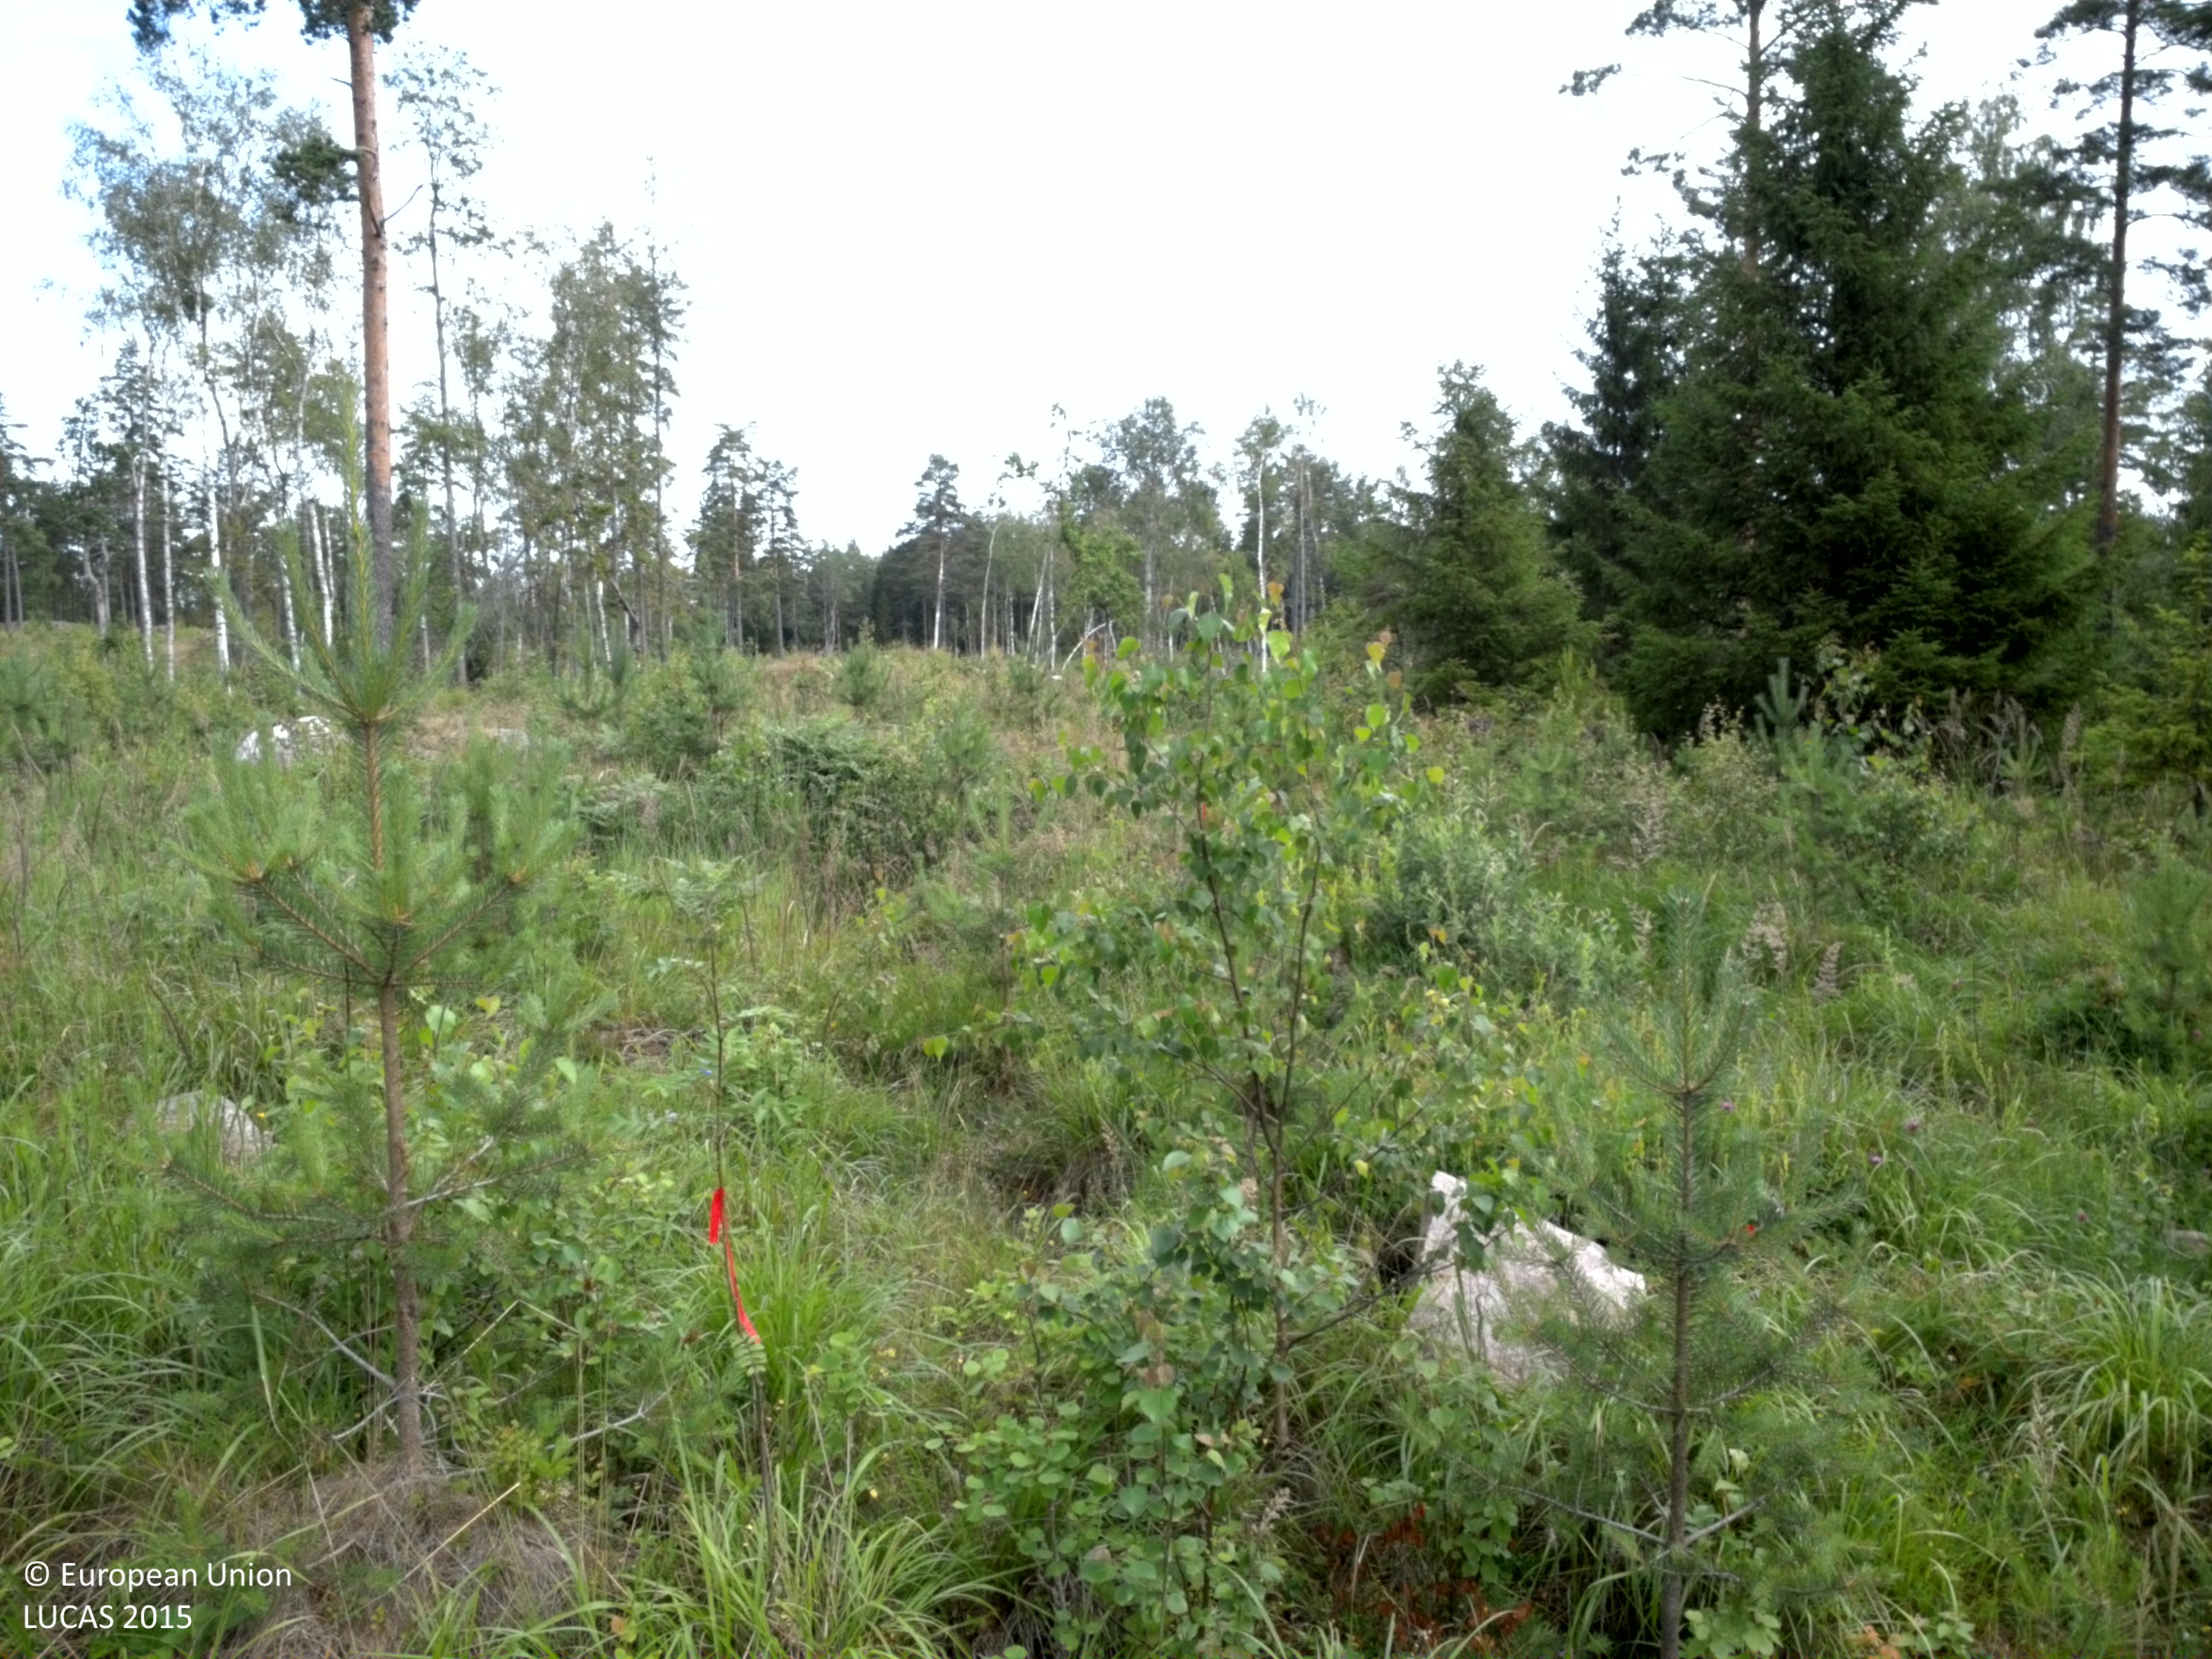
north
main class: Woodland
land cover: Pine dominated mixed woodland
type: boreal forest
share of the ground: 25 - 50 %
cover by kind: herbaceous plants 45 %, coniferous forest trees 30 %, lichens and mosses 15 %, broadleaved forest trees 10 %
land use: Forestry
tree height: < 5 m
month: July
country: SE
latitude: 60.0204
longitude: 18.7001
